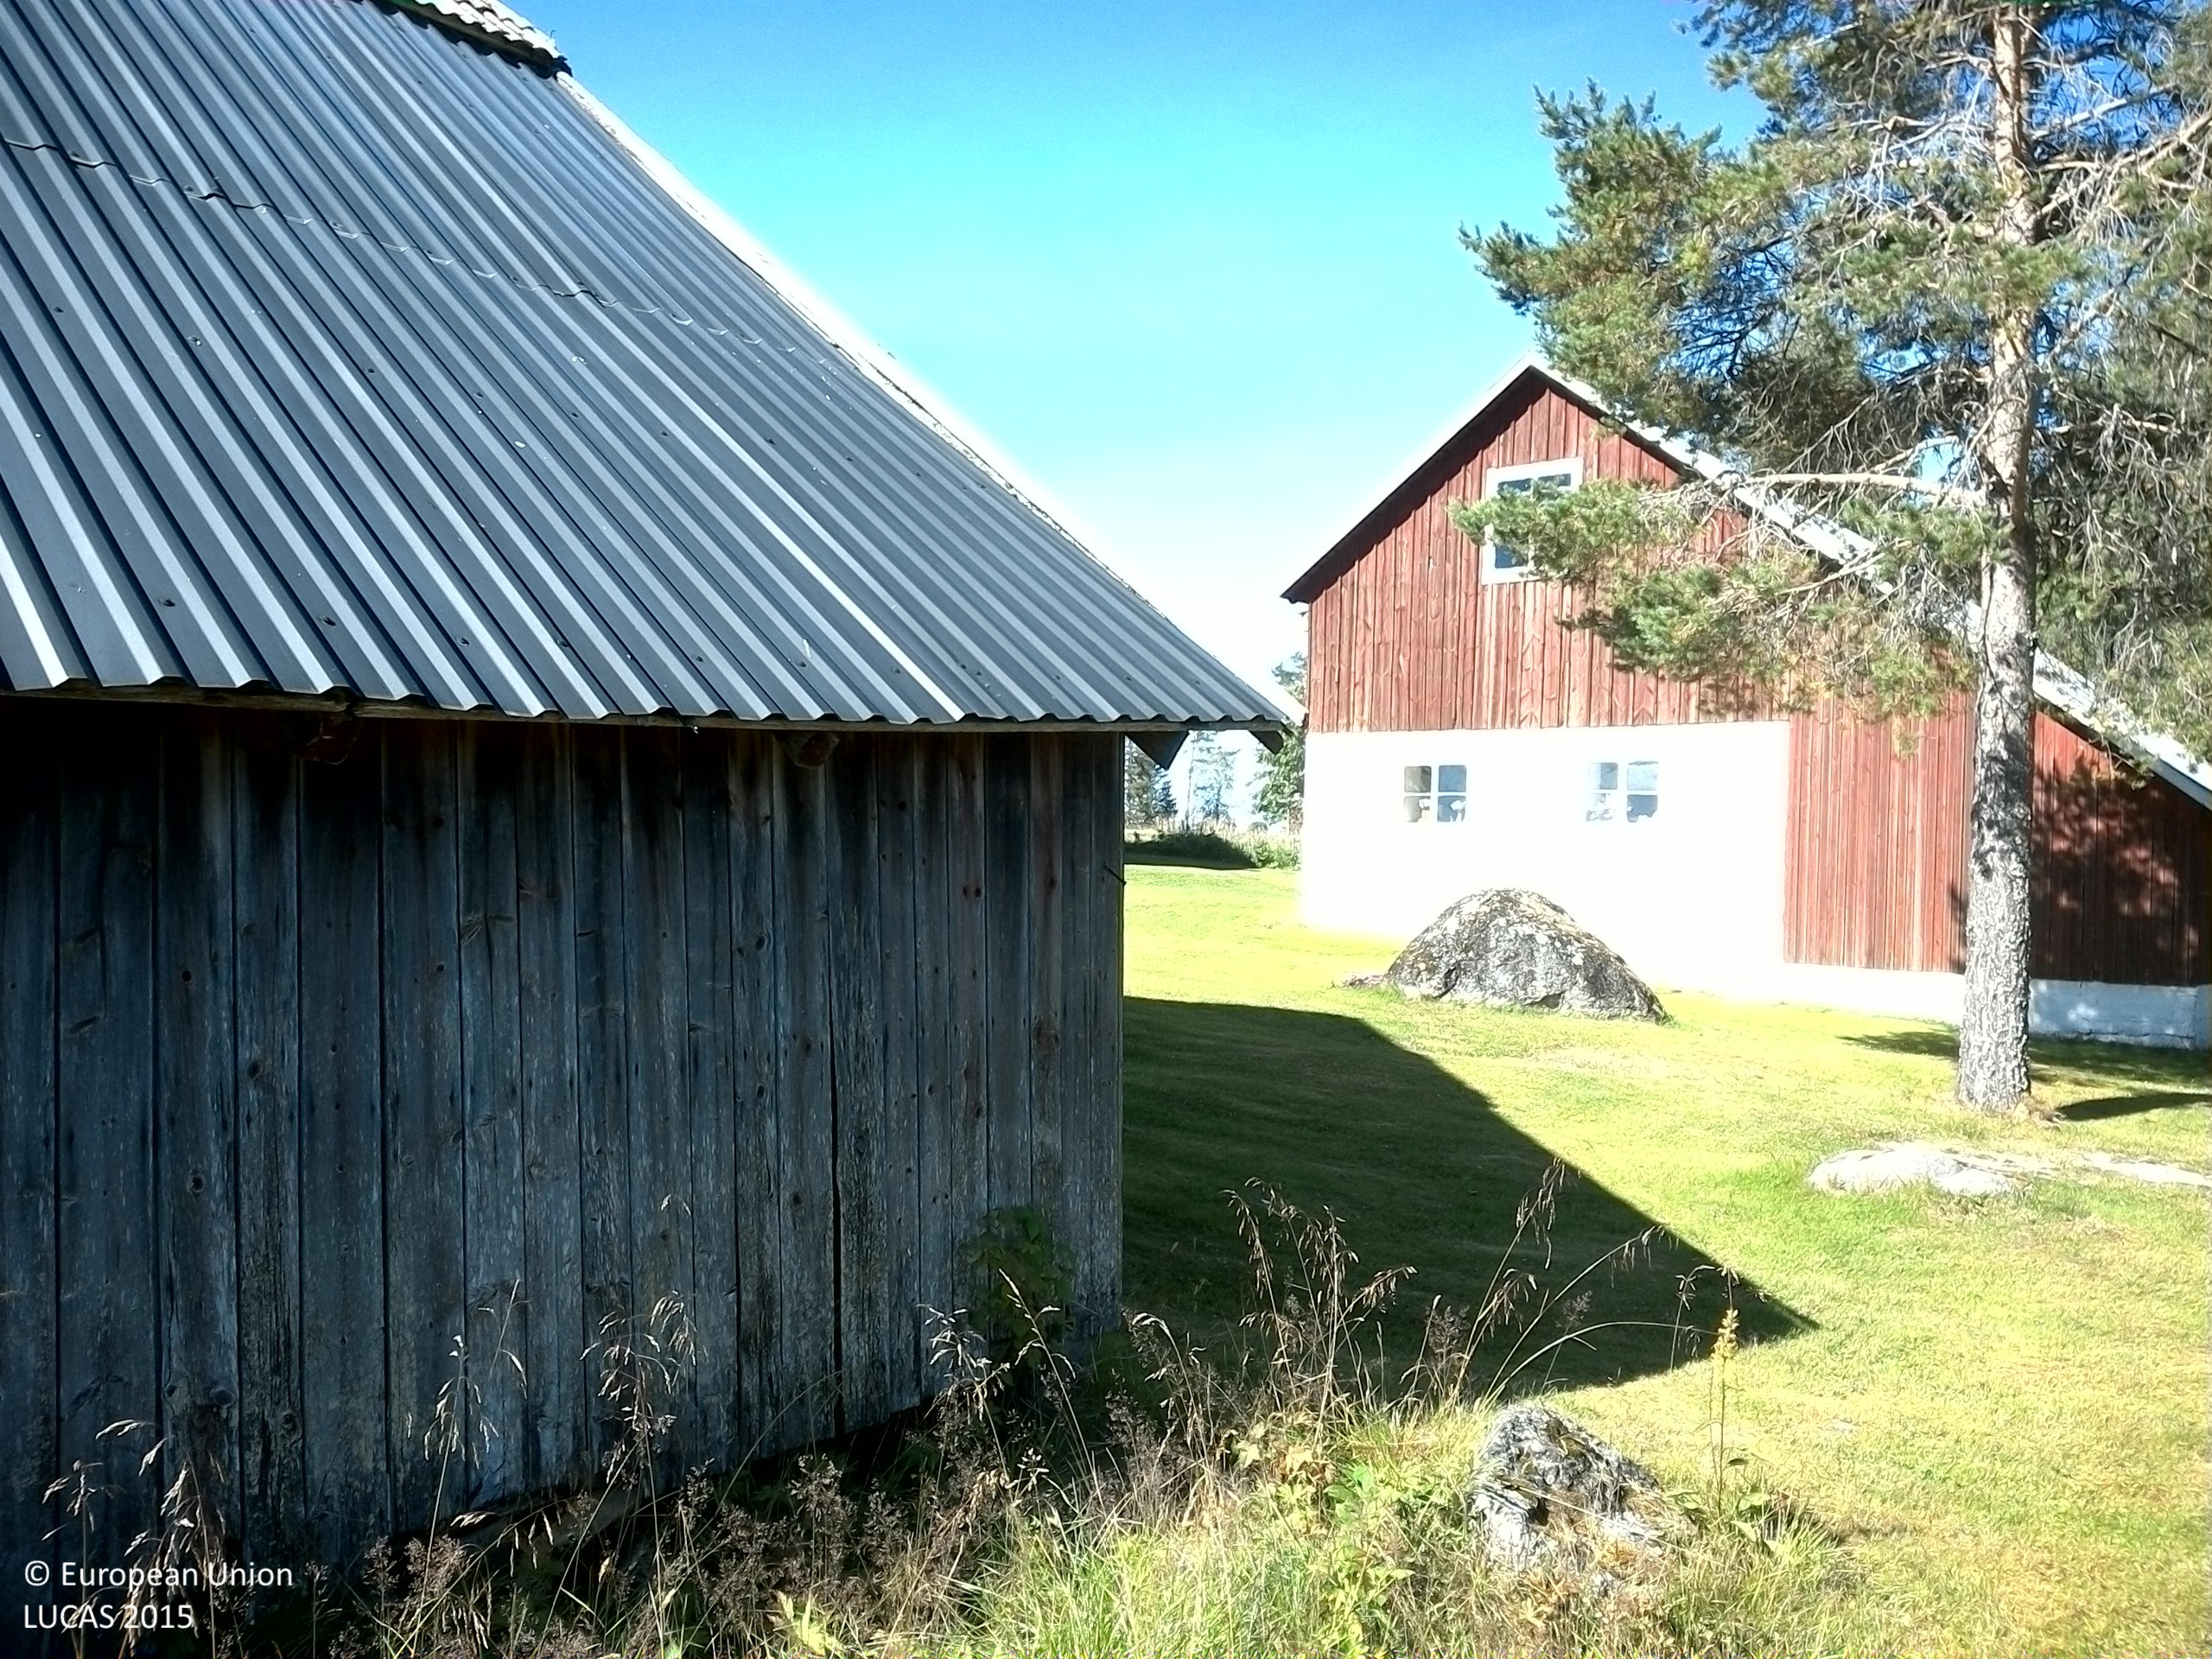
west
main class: Grassland
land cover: Grassland without tree/shrub cover
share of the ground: > 75 %
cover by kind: herbaceous plants 80 %, lichens and mosses 20 %
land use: Residential
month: August
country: SE
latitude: 63.7118
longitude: 17.8860
